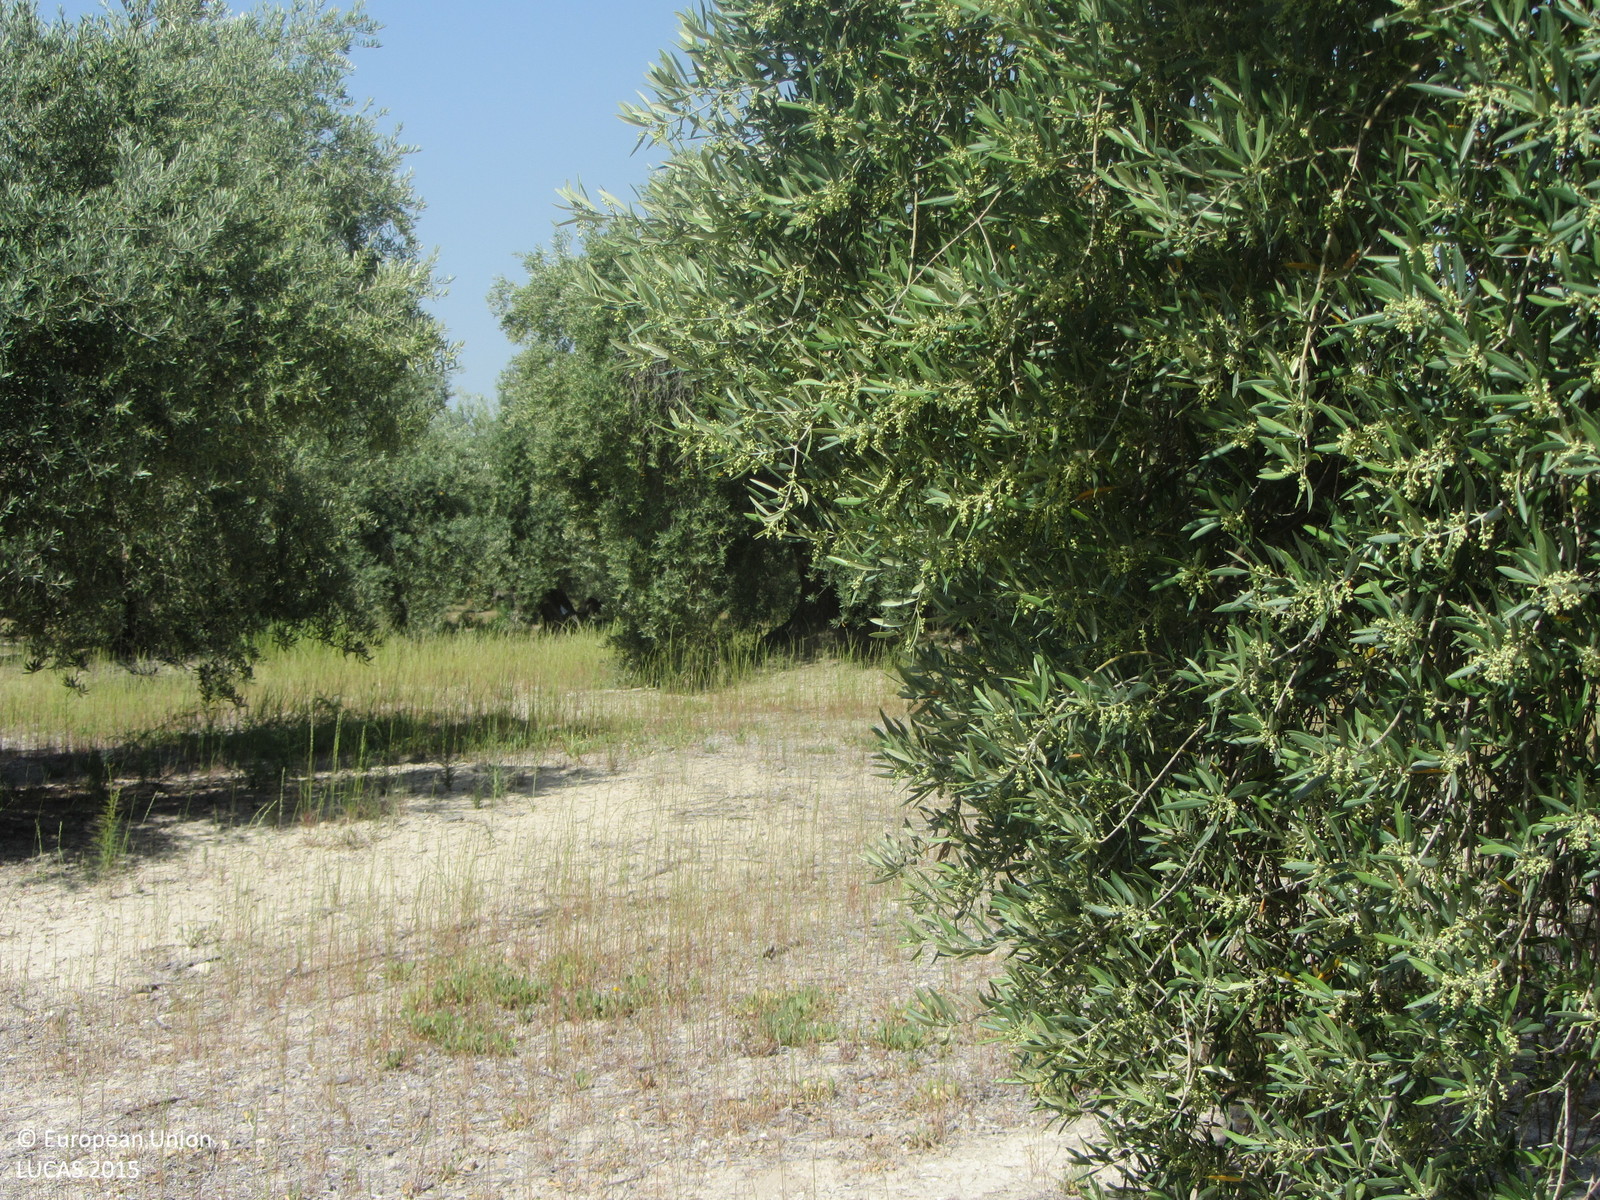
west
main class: Cropland
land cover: Olive groves
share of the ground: 25 - 50 %
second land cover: Spontaneously vegetated surfaces
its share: 10 - 25 %
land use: Agriculture (excluding fallow land and kitchen gardens)
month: May
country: ES
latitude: 38.2156
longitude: -3.0778
